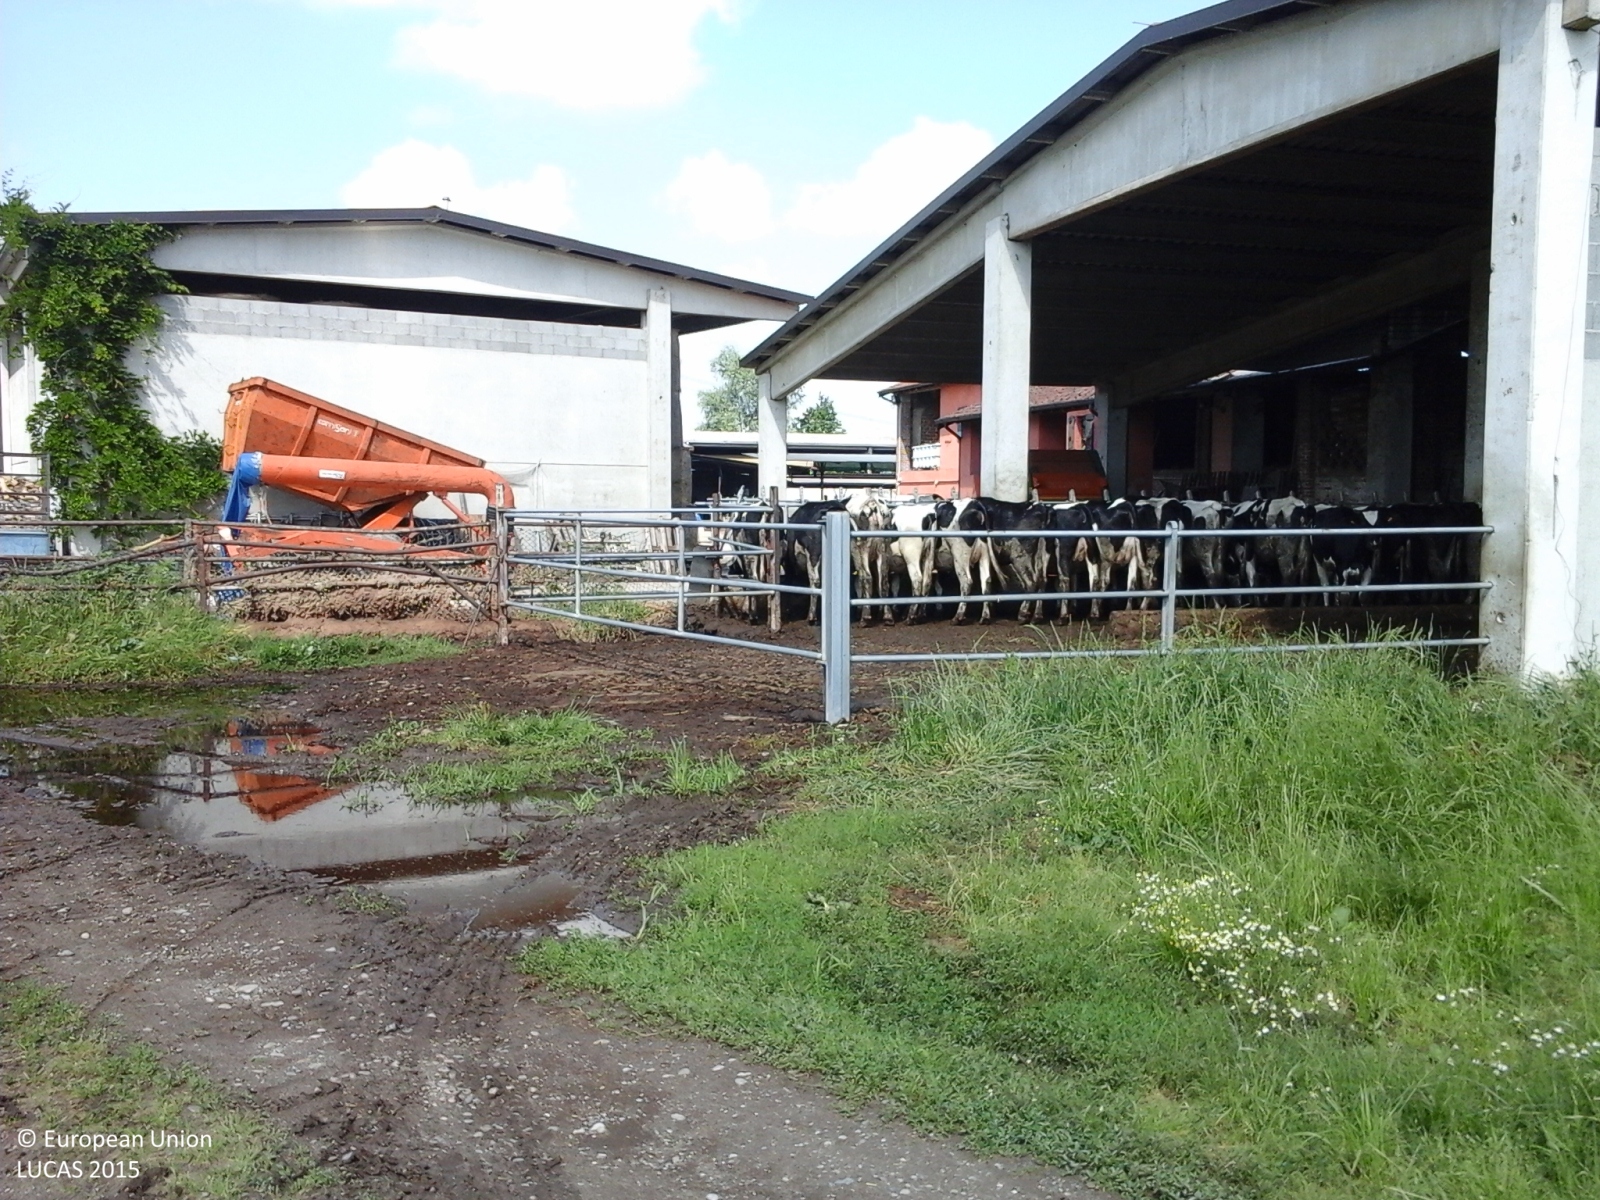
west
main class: Cropland
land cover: Maize
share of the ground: > 75 %
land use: Agriculture (excluding fallow land and kitchen gardens)
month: May
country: IT
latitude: 45.3773
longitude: 9.5538
